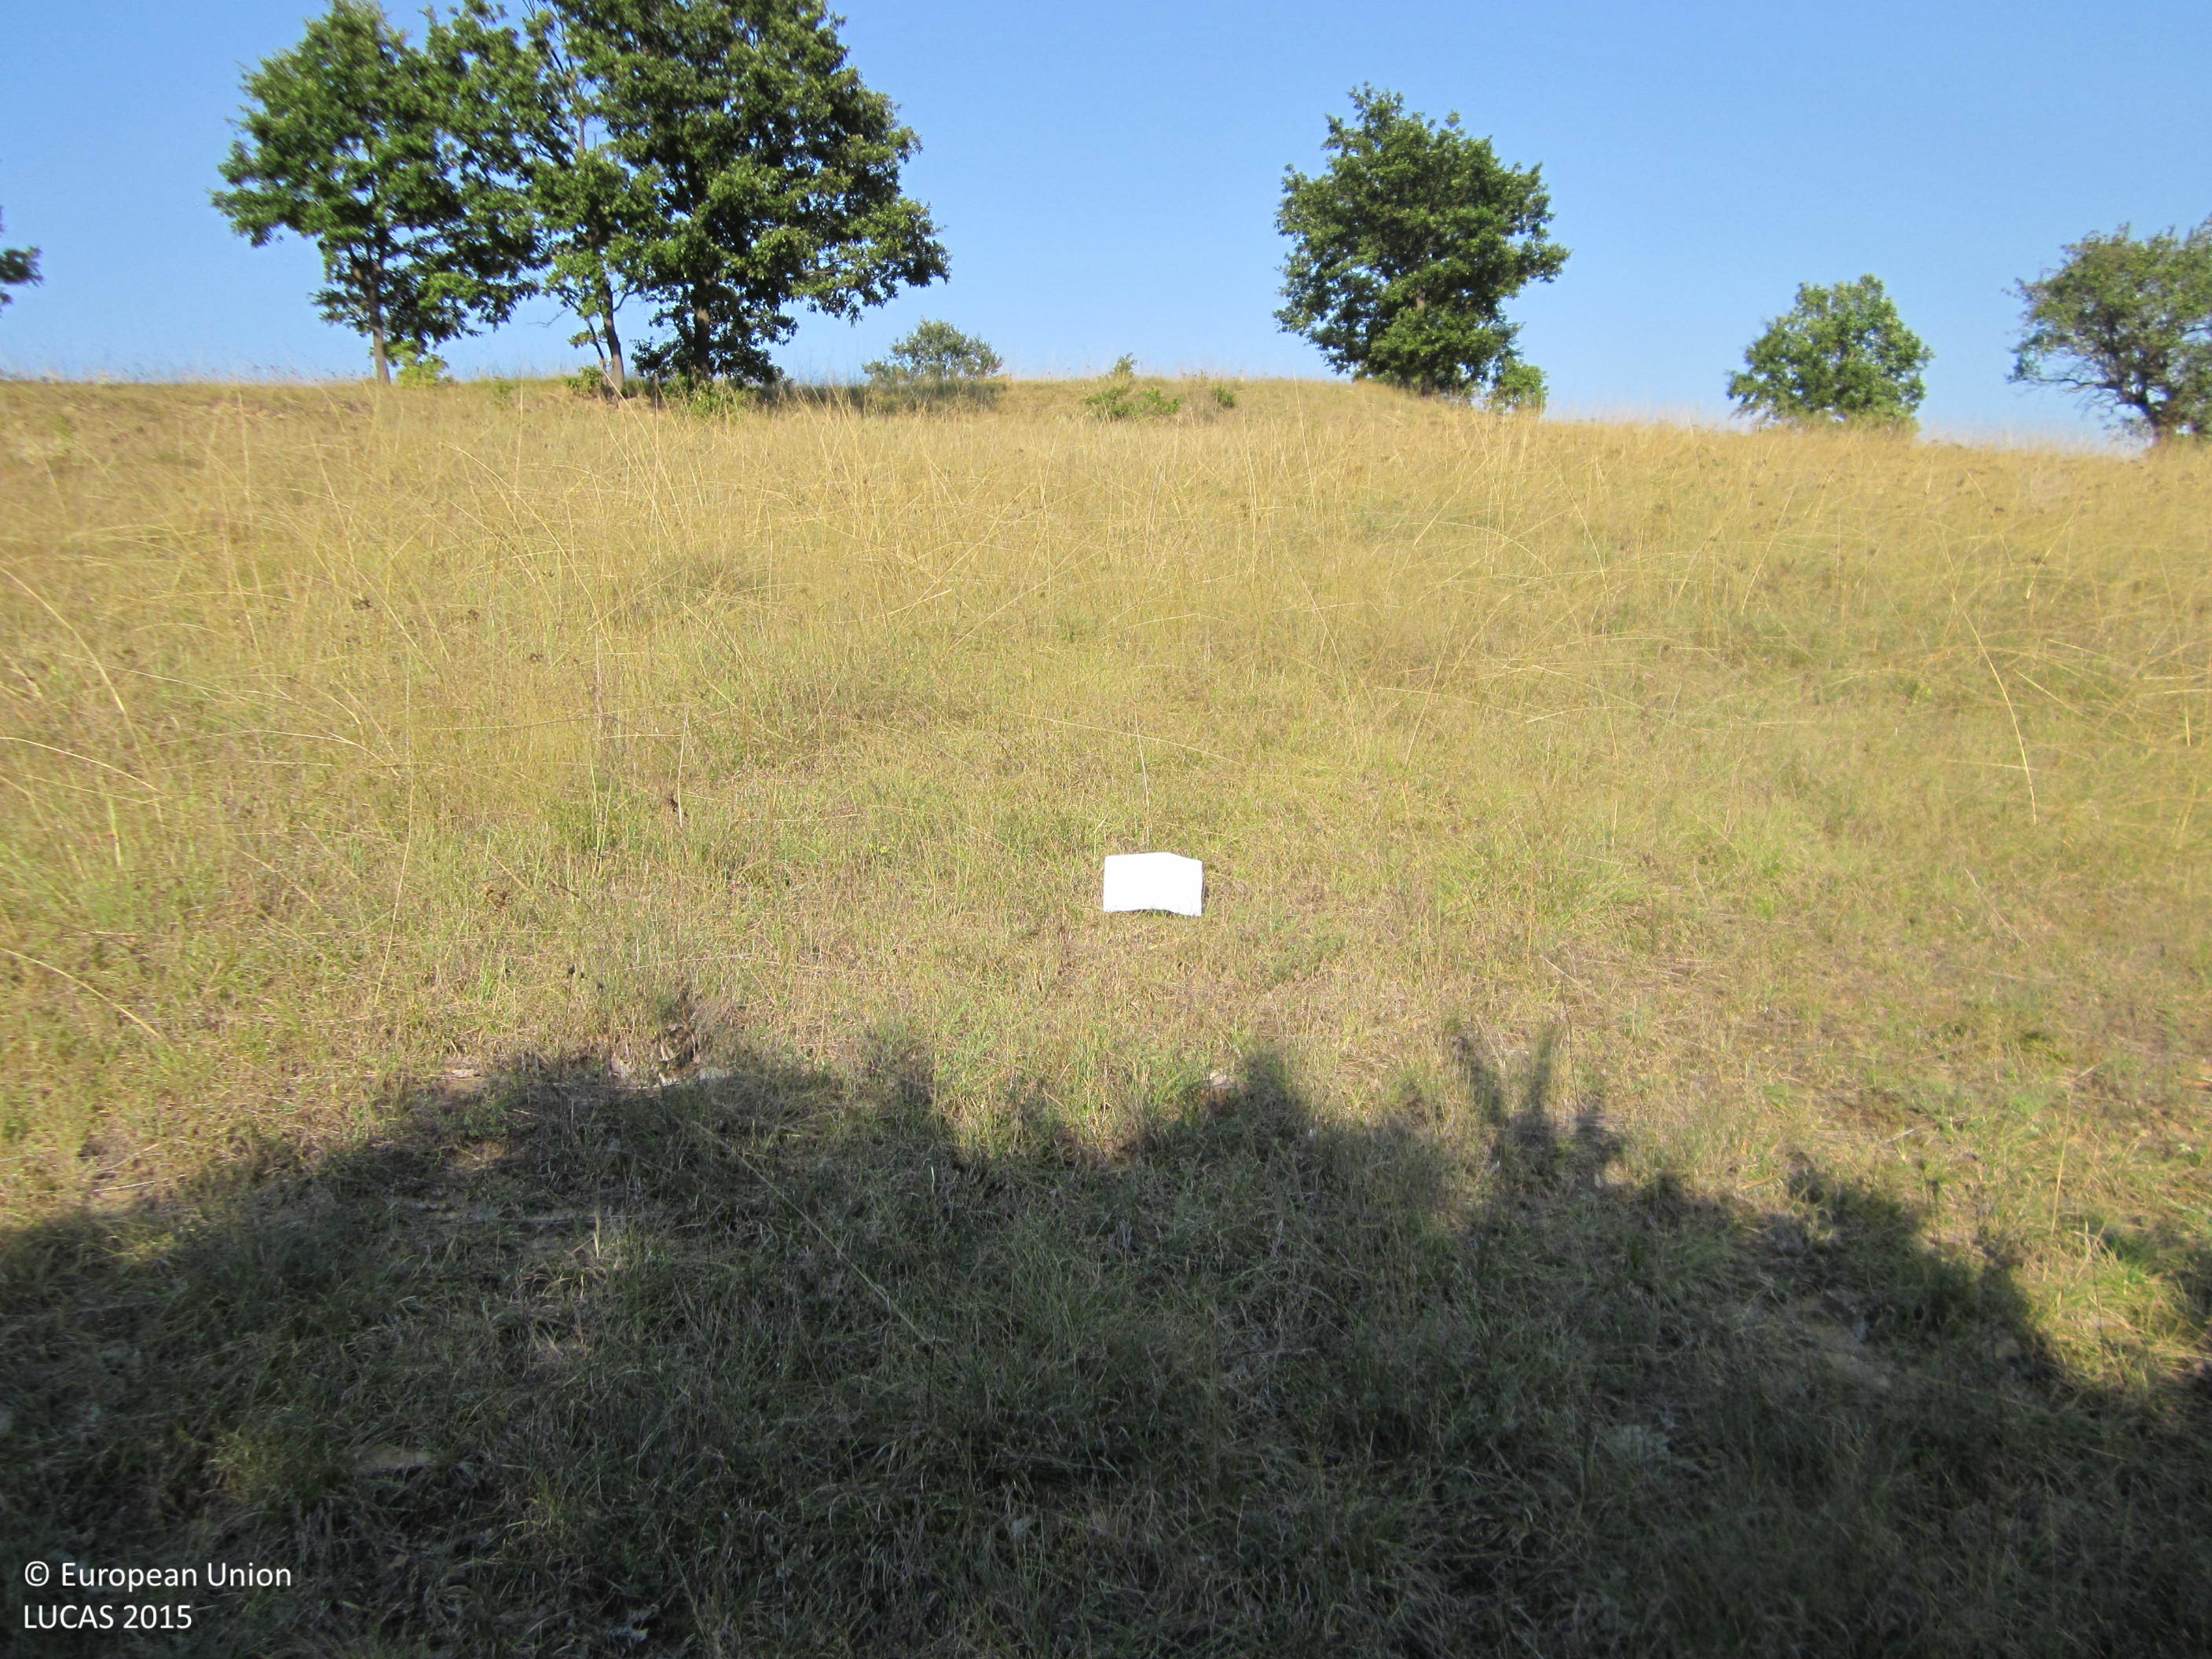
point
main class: Grassland
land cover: Grassland without tree/shrub cover
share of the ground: > 75 %
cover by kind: herbaceous plants 100 %
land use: Agriculture (excluding fallow land and kitchen gardens)
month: September
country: BG
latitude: 42.8474
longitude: 27.0834
